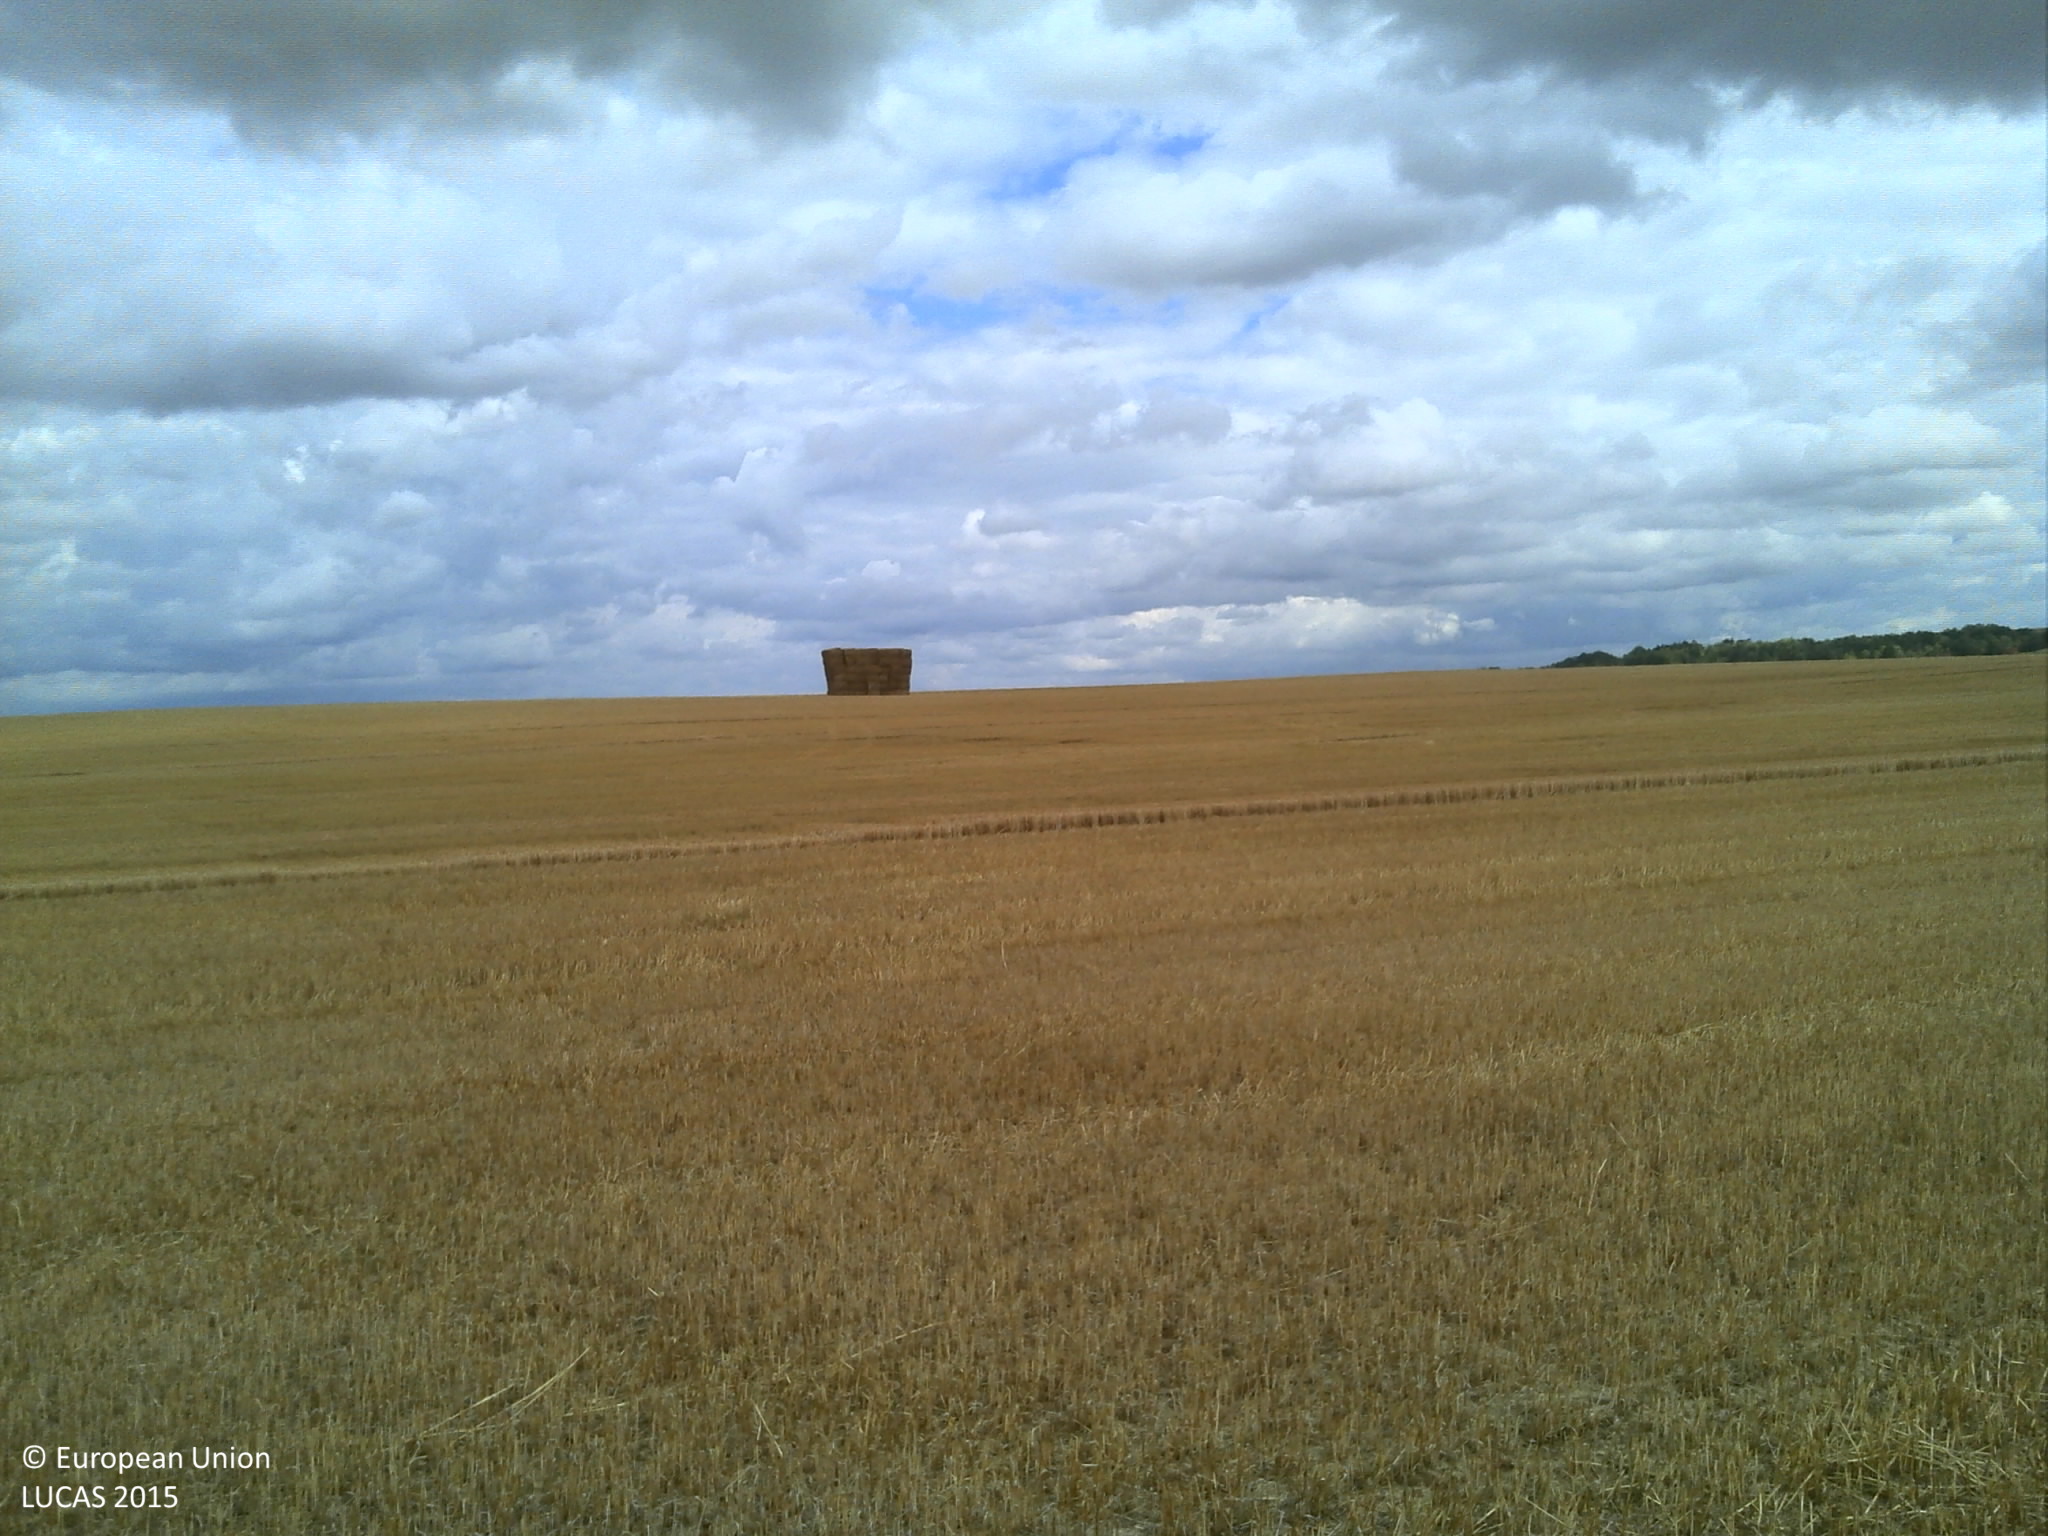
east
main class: Cropland
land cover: Barley
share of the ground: 50 - 75 %
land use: Agriculture (excluding fallow land and kitchen gardens)
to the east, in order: Barley; Common wheat
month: July
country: FR
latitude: 49.3501
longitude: 4.5314
